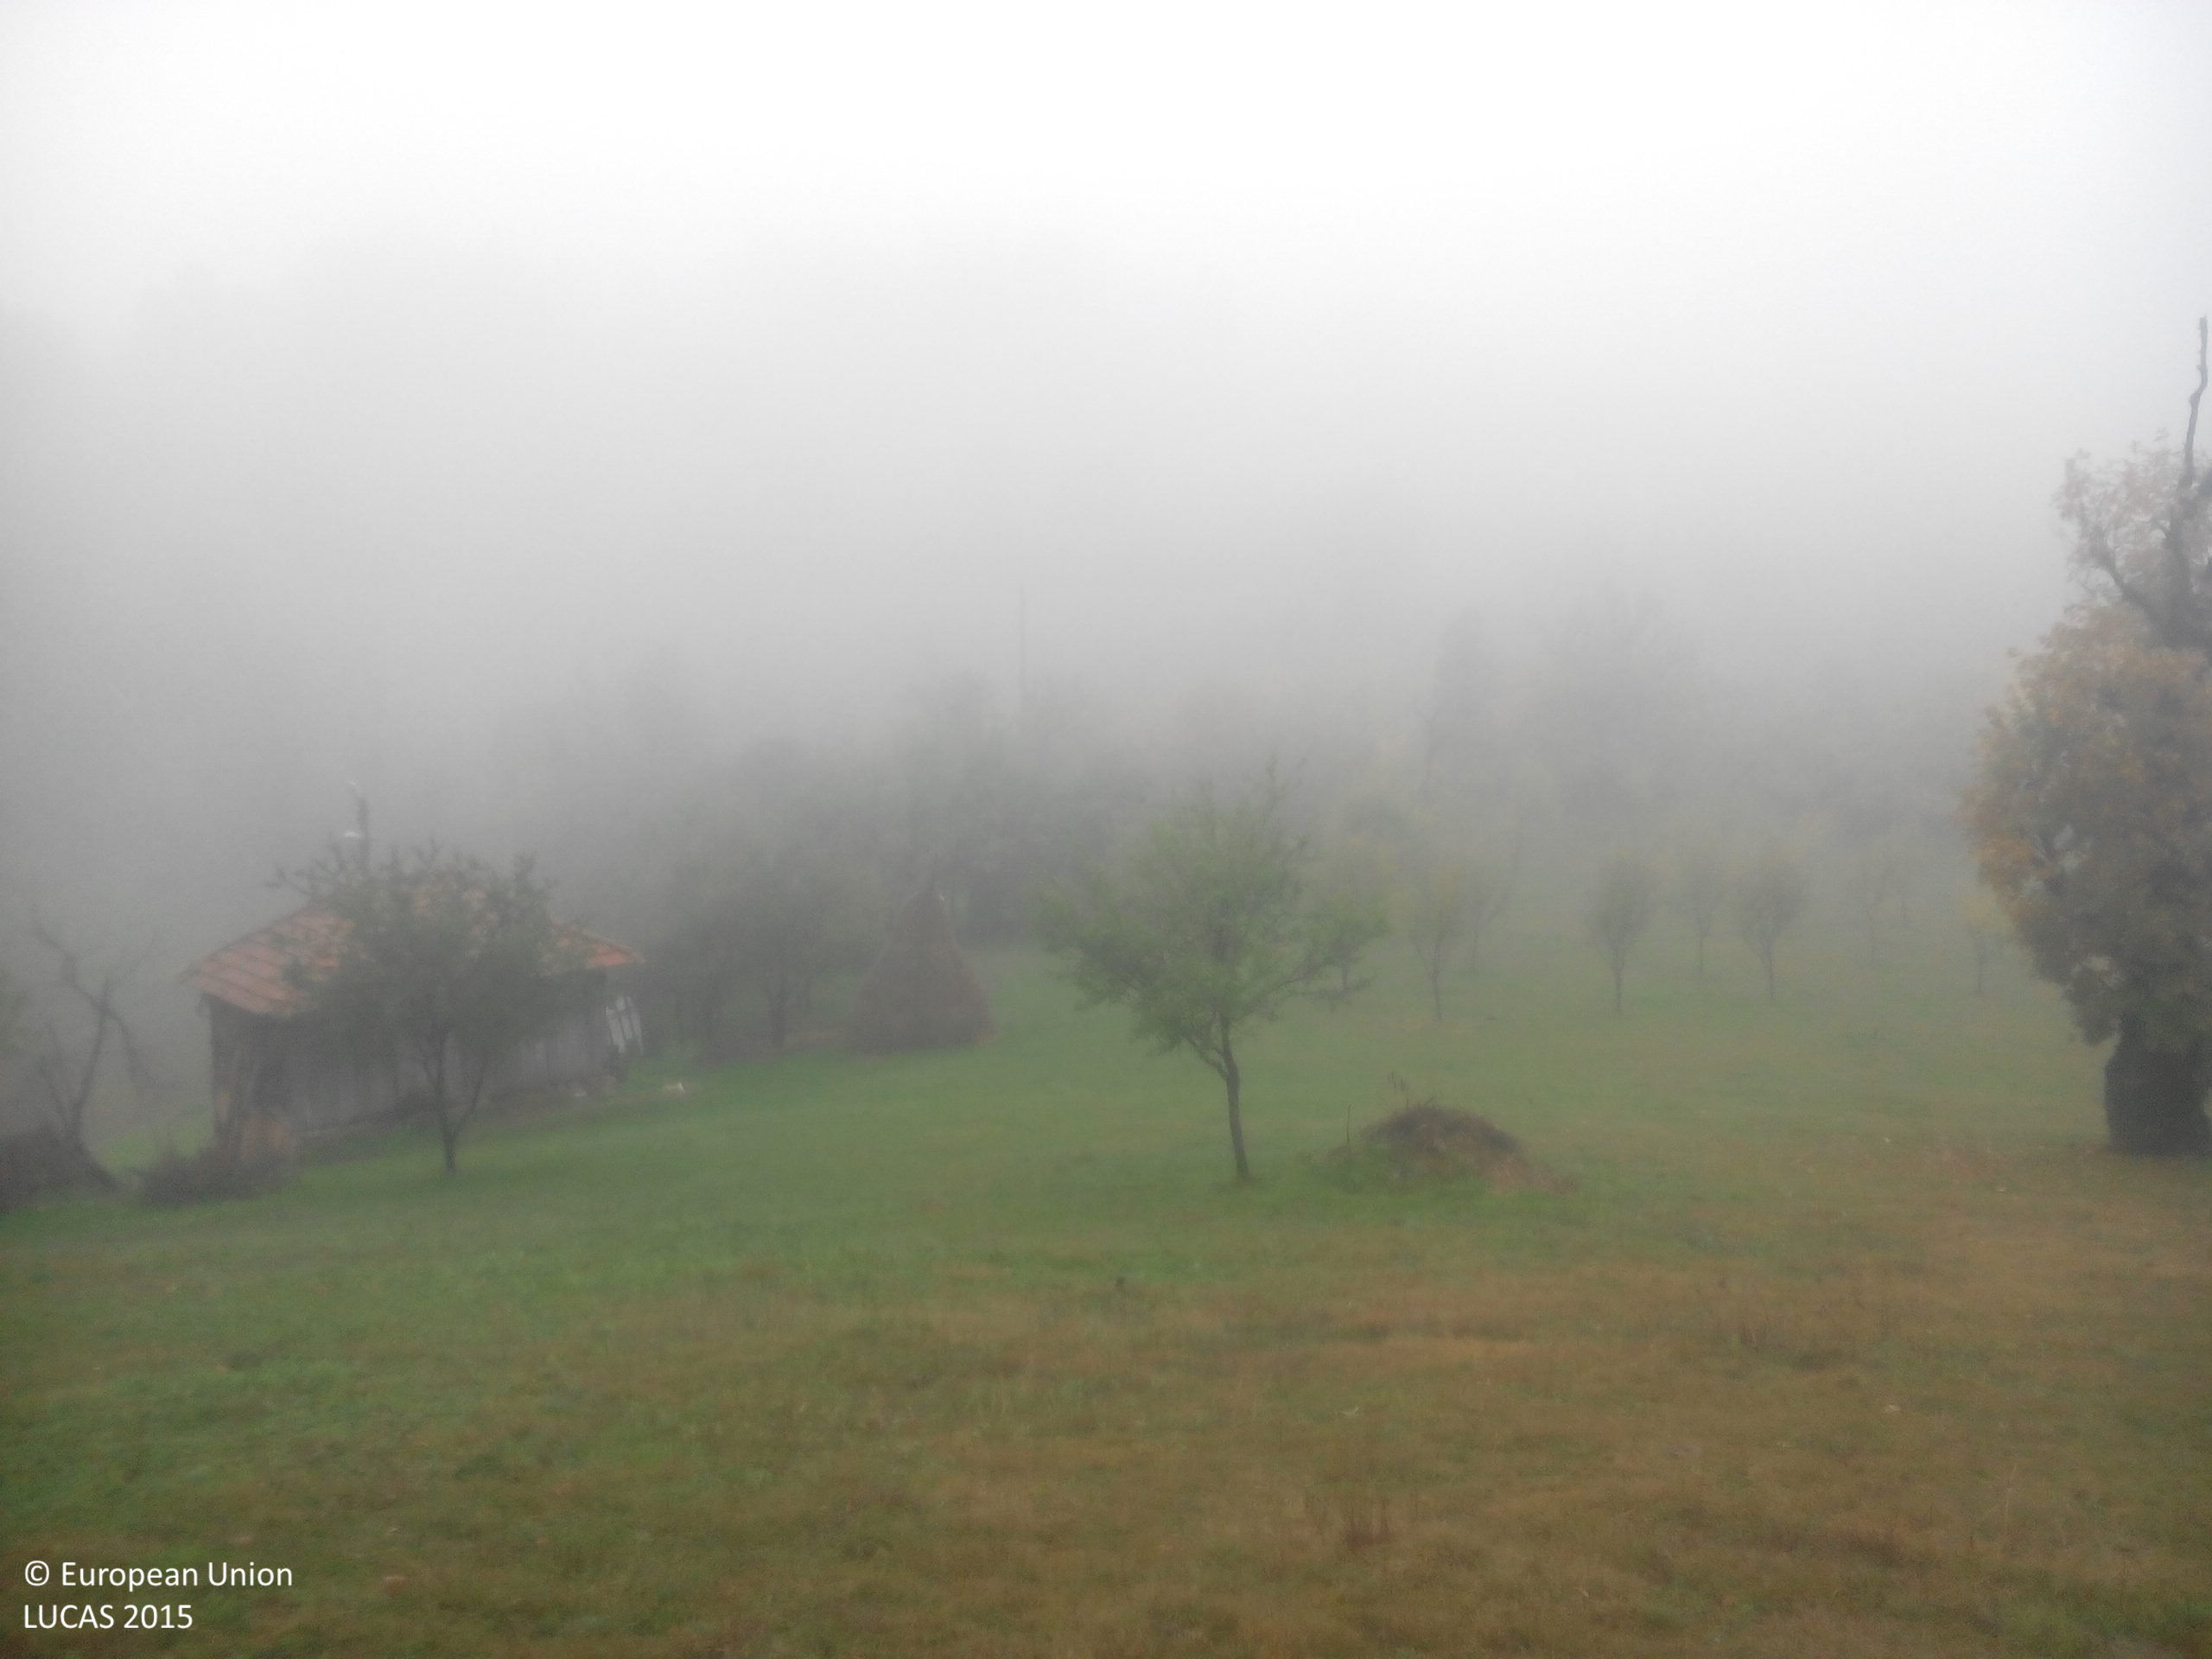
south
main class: Grassland
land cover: Grassland with sparse tree/shrub cover
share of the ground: > 75 %
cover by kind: herbaceous plants 90 %, broadleaved forest trees 5 %, shrubs 5 %
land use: Agriculture (excluding fallow land and kitchen gardens)
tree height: > 5 m
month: October
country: BG
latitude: 42.9716
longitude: 24.2875
